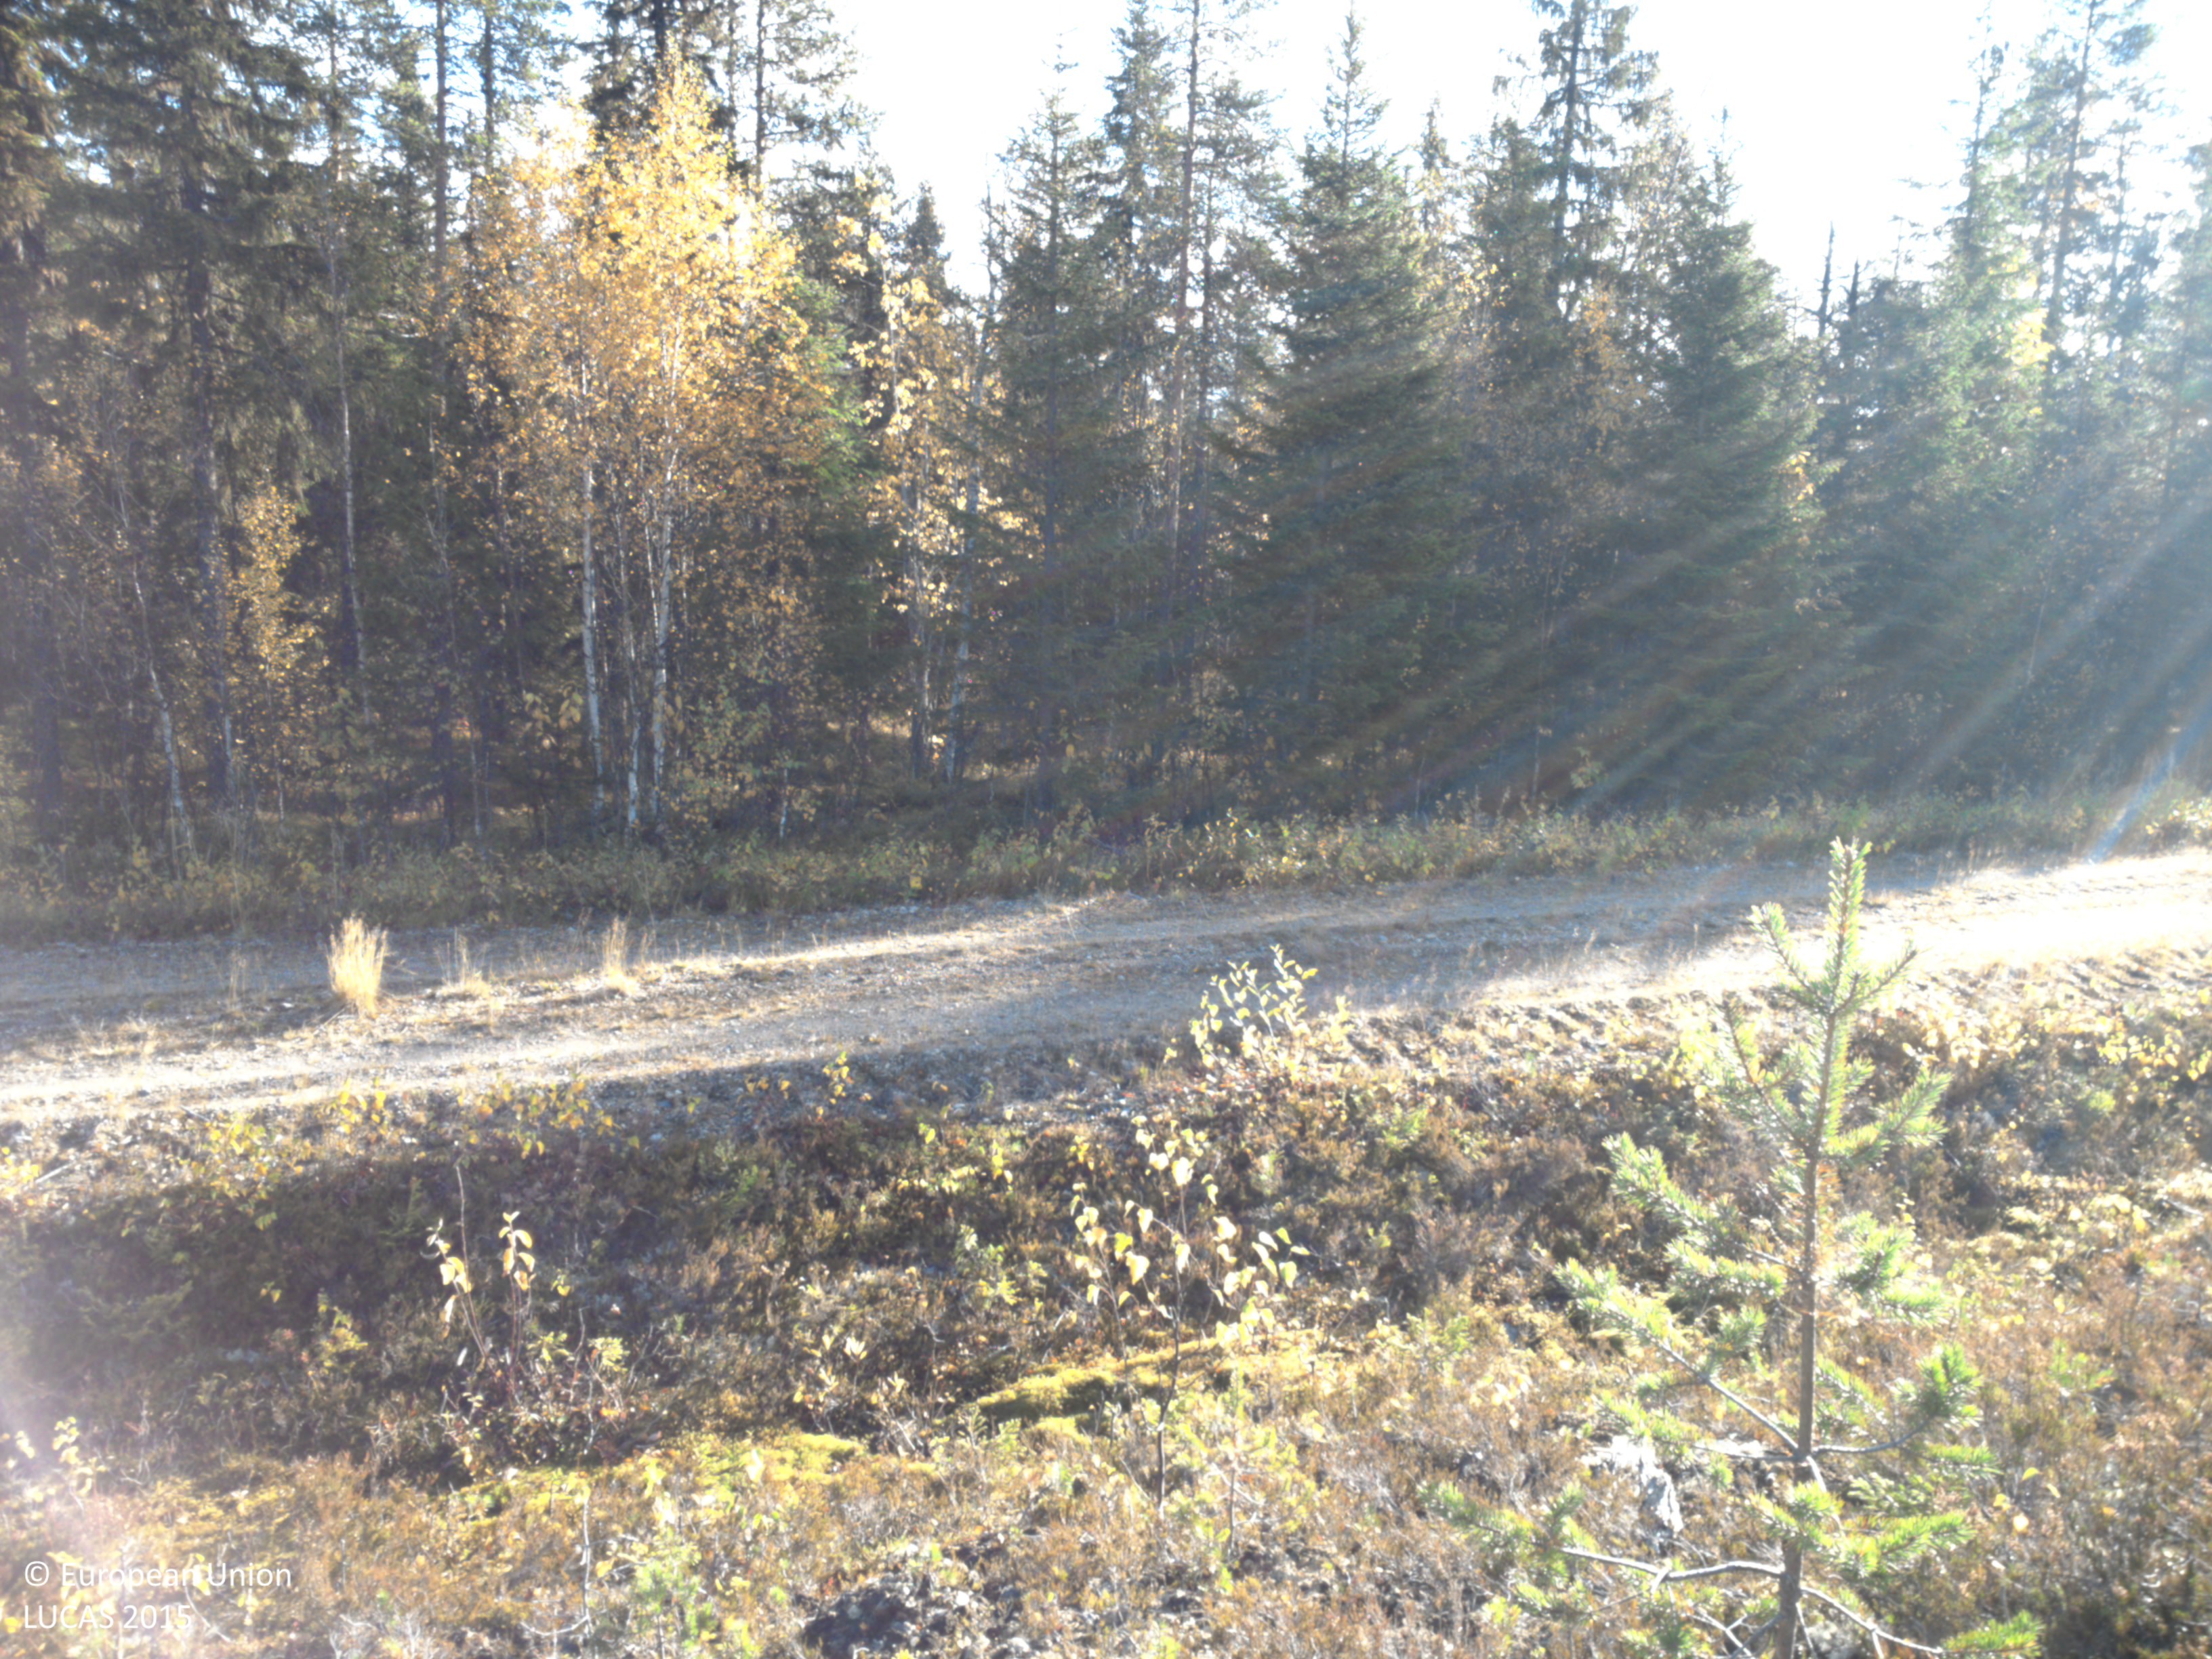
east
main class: Woodland
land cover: Pine dominated coniferous woodland
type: exotic forest
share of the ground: 50 - 75 %
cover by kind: coniferous forest trees 50 %, shrubs 30 %, broadleaved forest trees 10 %, herbaceous plants 5 %, lichens and mosses 5 %
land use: Forestry
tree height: < 5 m
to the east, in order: Pine dominated coniferous woodland; Shrubland with sparse tree cover; Paved roads, cycling and walking lanes; Shruby margins; Other mixed woodland; Spruce dominated coniferous woodland; Pine dominated coniferous woodland
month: September
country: SE
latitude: 64.8850
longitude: 18.3903
